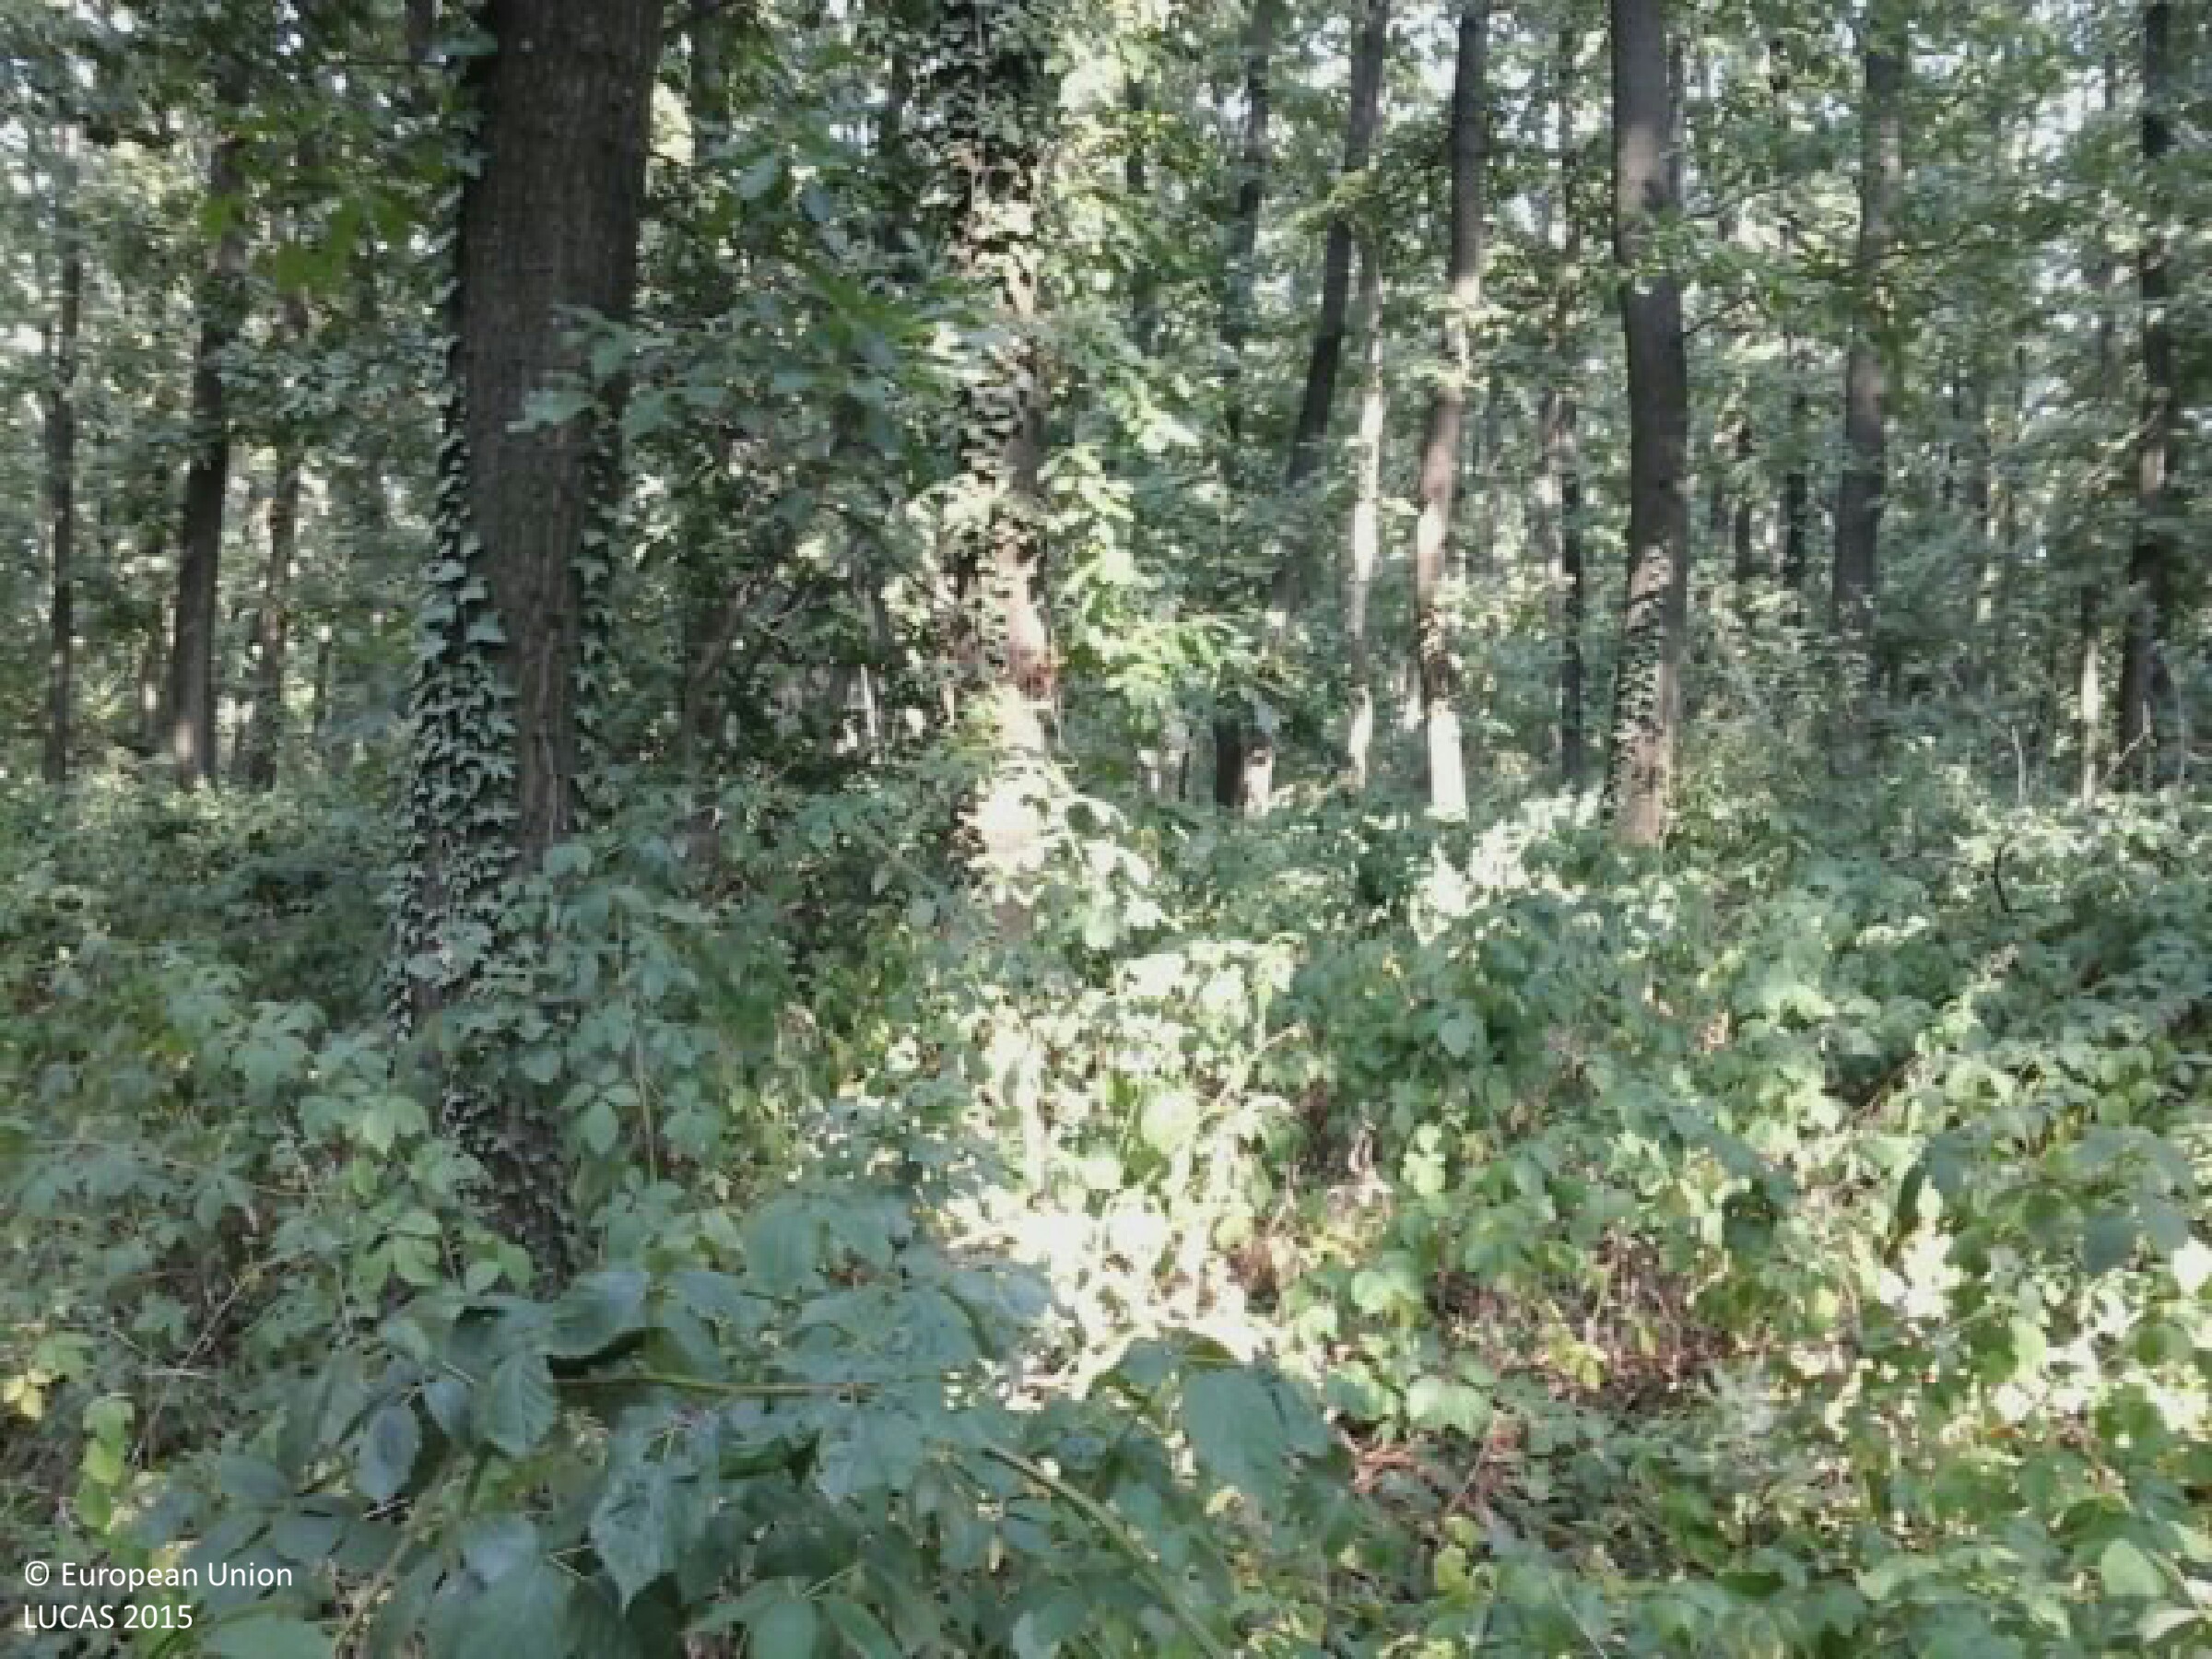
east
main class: Woodland
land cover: Broadleaved woodland
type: mesophytic deciduous forest
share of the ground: > 75 %
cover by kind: broadleaved forest trees 90 %, shrubs 5 %, herbaceous plants 5 %
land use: Forestry
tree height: > 5 m
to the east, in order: Broadleaved woodland; Tracks; Broadleaved woodland; Tracks; Broadleaved woodland
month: August
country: HU
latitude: 46.5596
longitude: 17.9777
